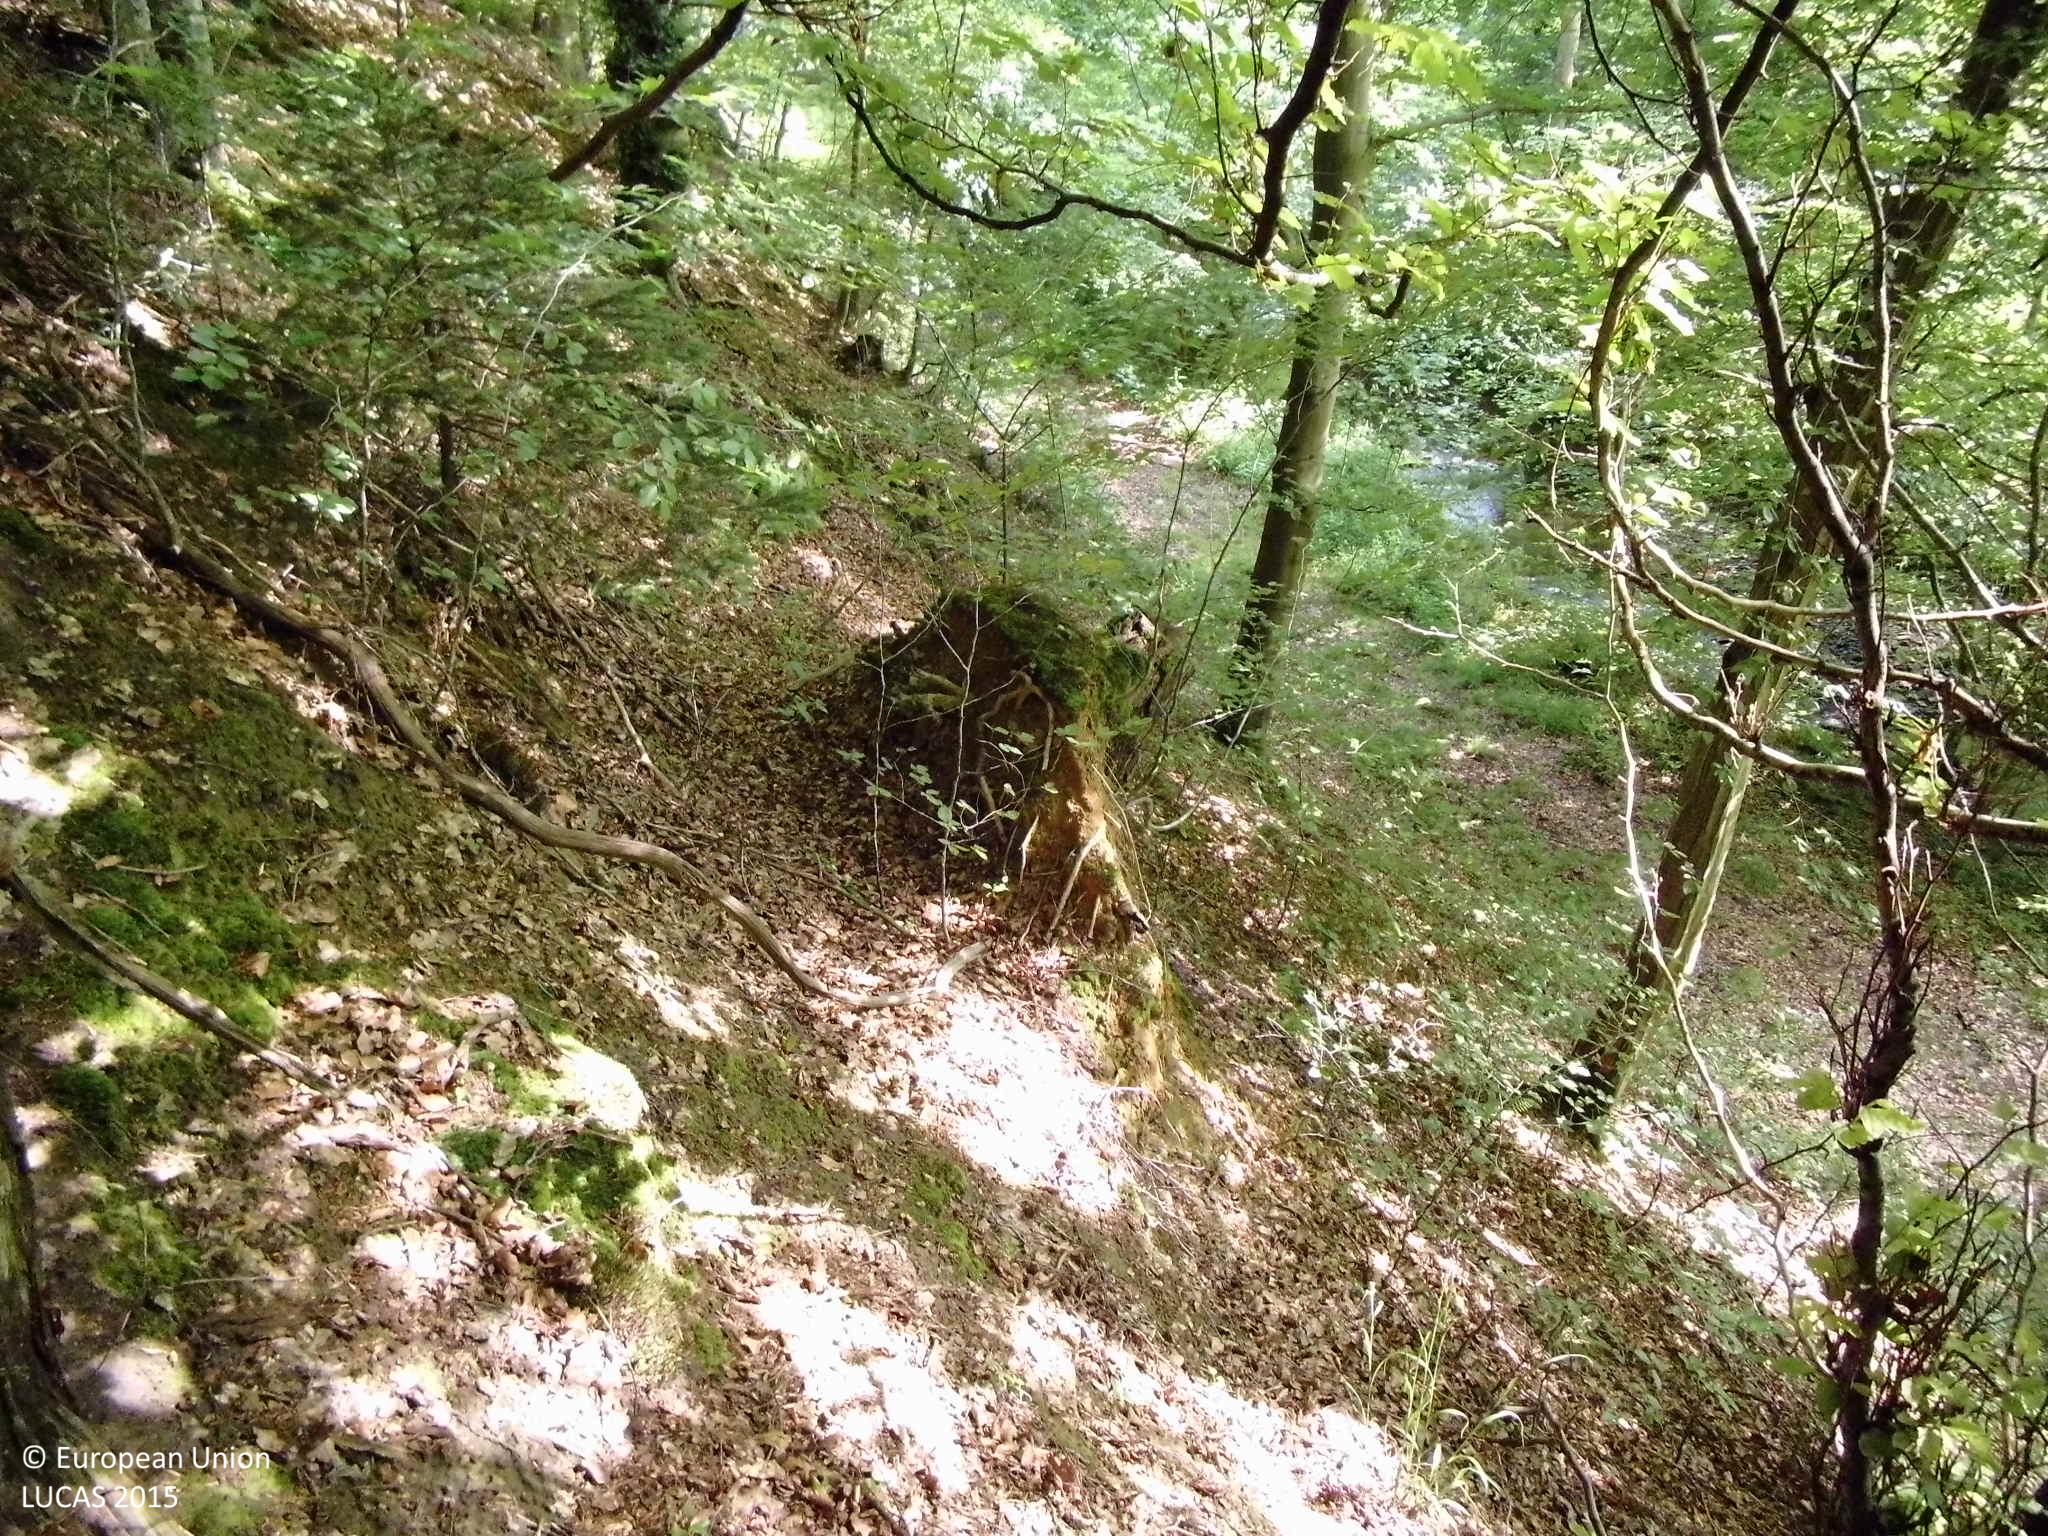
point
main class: Woodland
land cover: Broadleaved woodland
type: beech forest
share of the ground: > 75 %
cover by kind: broadleaved forest trees 90 %, coniferous forest trees 10 %
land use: Forestry
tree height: > 5 m
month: June
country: DE
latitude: 50.7491
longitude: 7.4349
